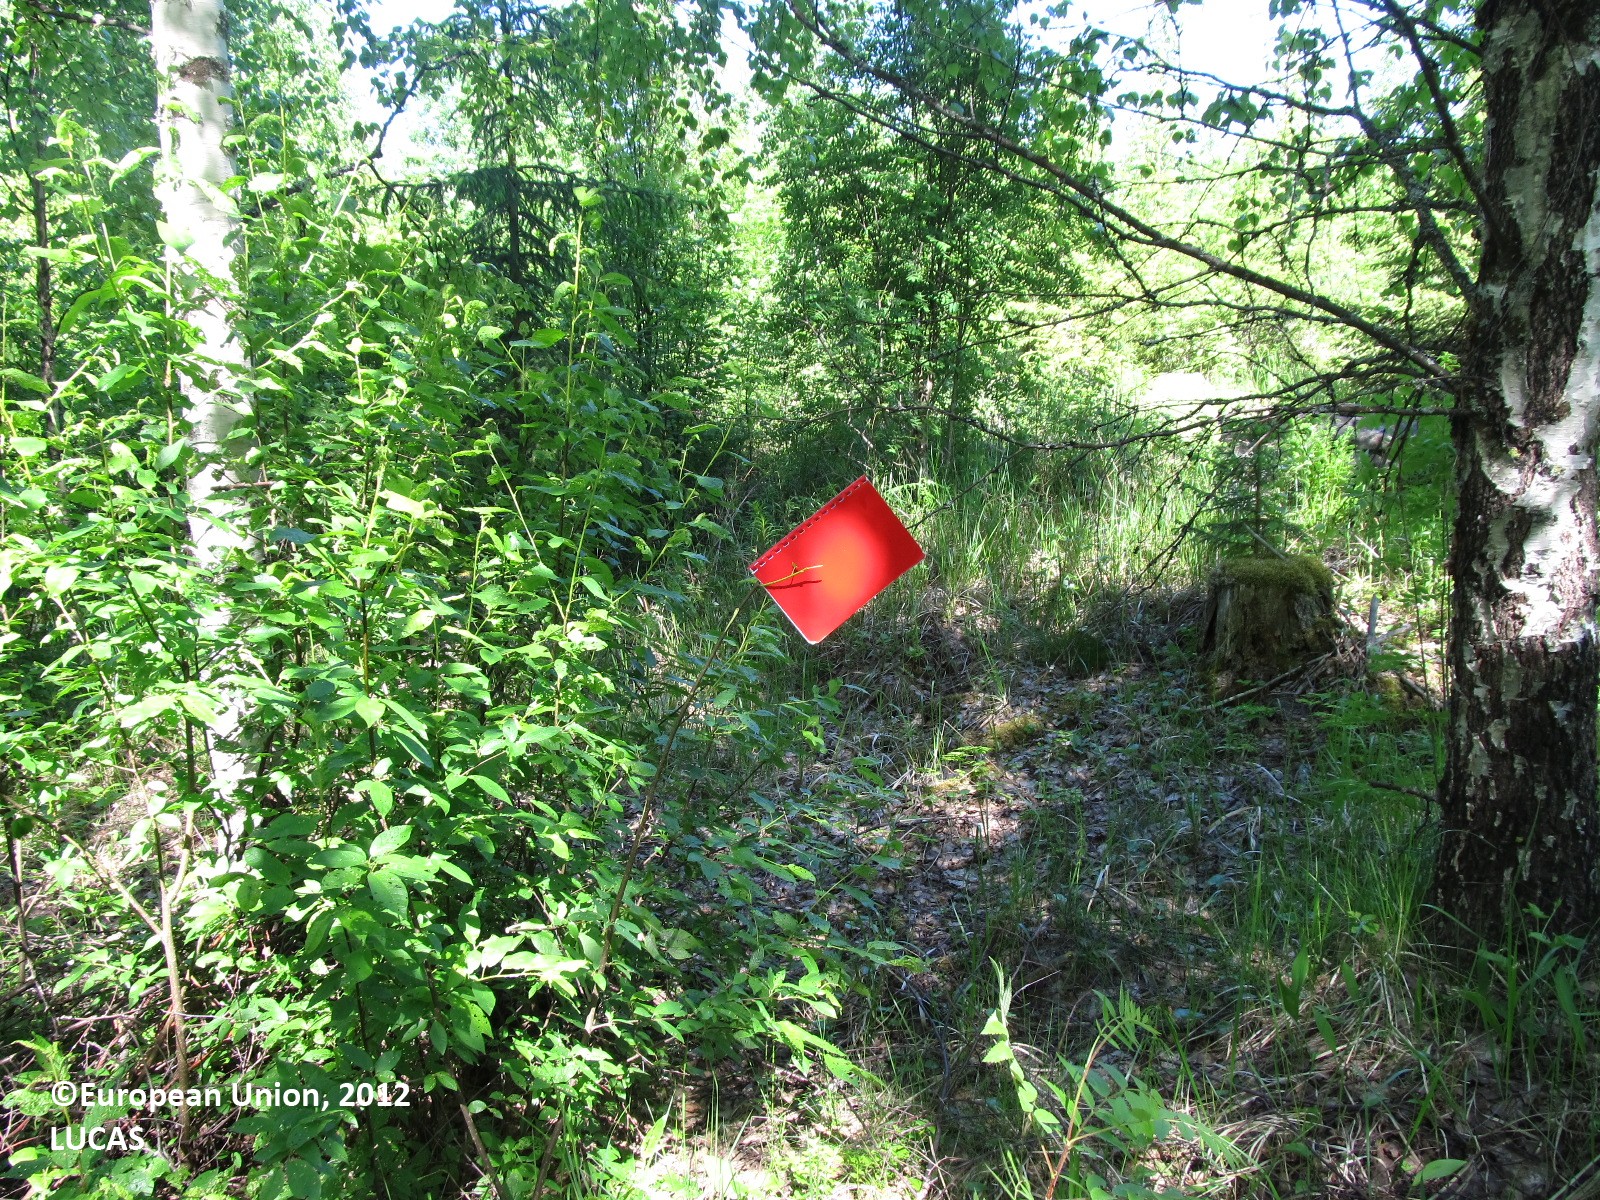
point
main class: Woodland
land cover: Broadleaved woodland
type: boreal forest
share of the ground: 50 - 75 %
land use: Forestry
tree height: > 5 m
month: June
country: FI
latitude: 62.6761
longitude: 27.4457
